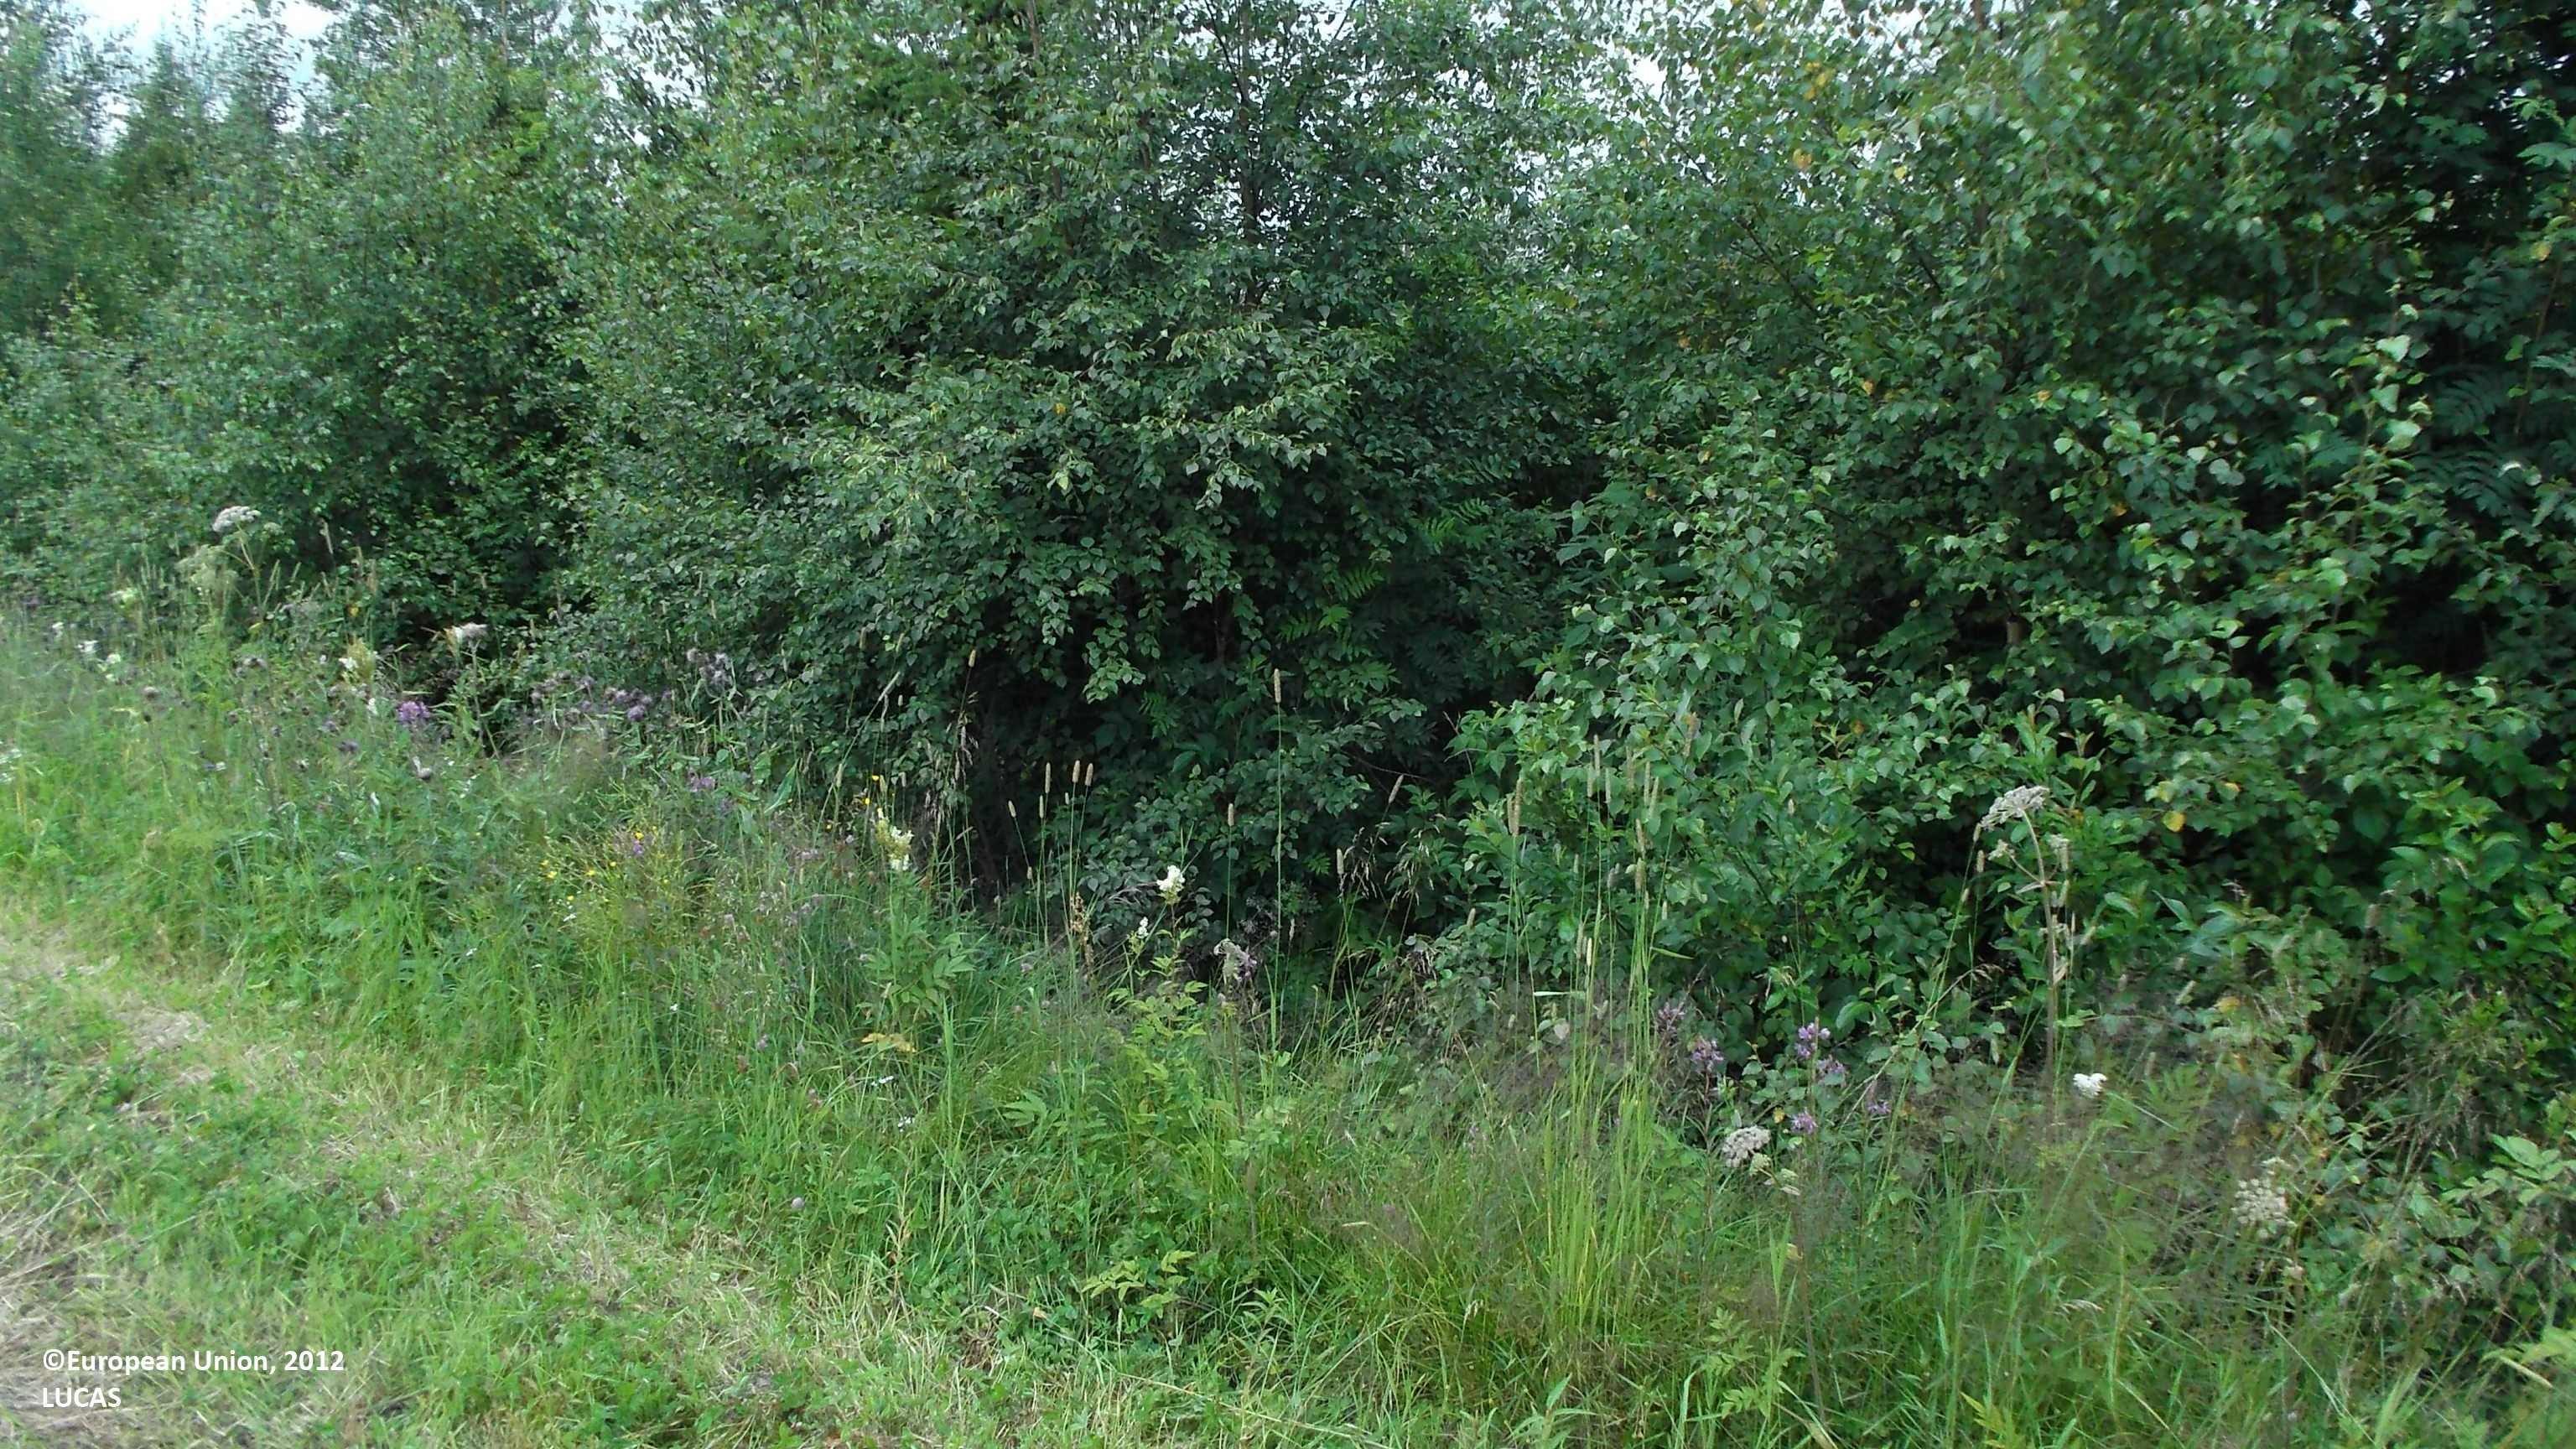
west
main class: Cropland
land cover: Temporary grasslands
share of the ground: > 75 %
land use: Agriculture (excluding fallow land and kitchen gardens)
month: July
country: FI
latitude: 63.7018
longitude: 23.1437
